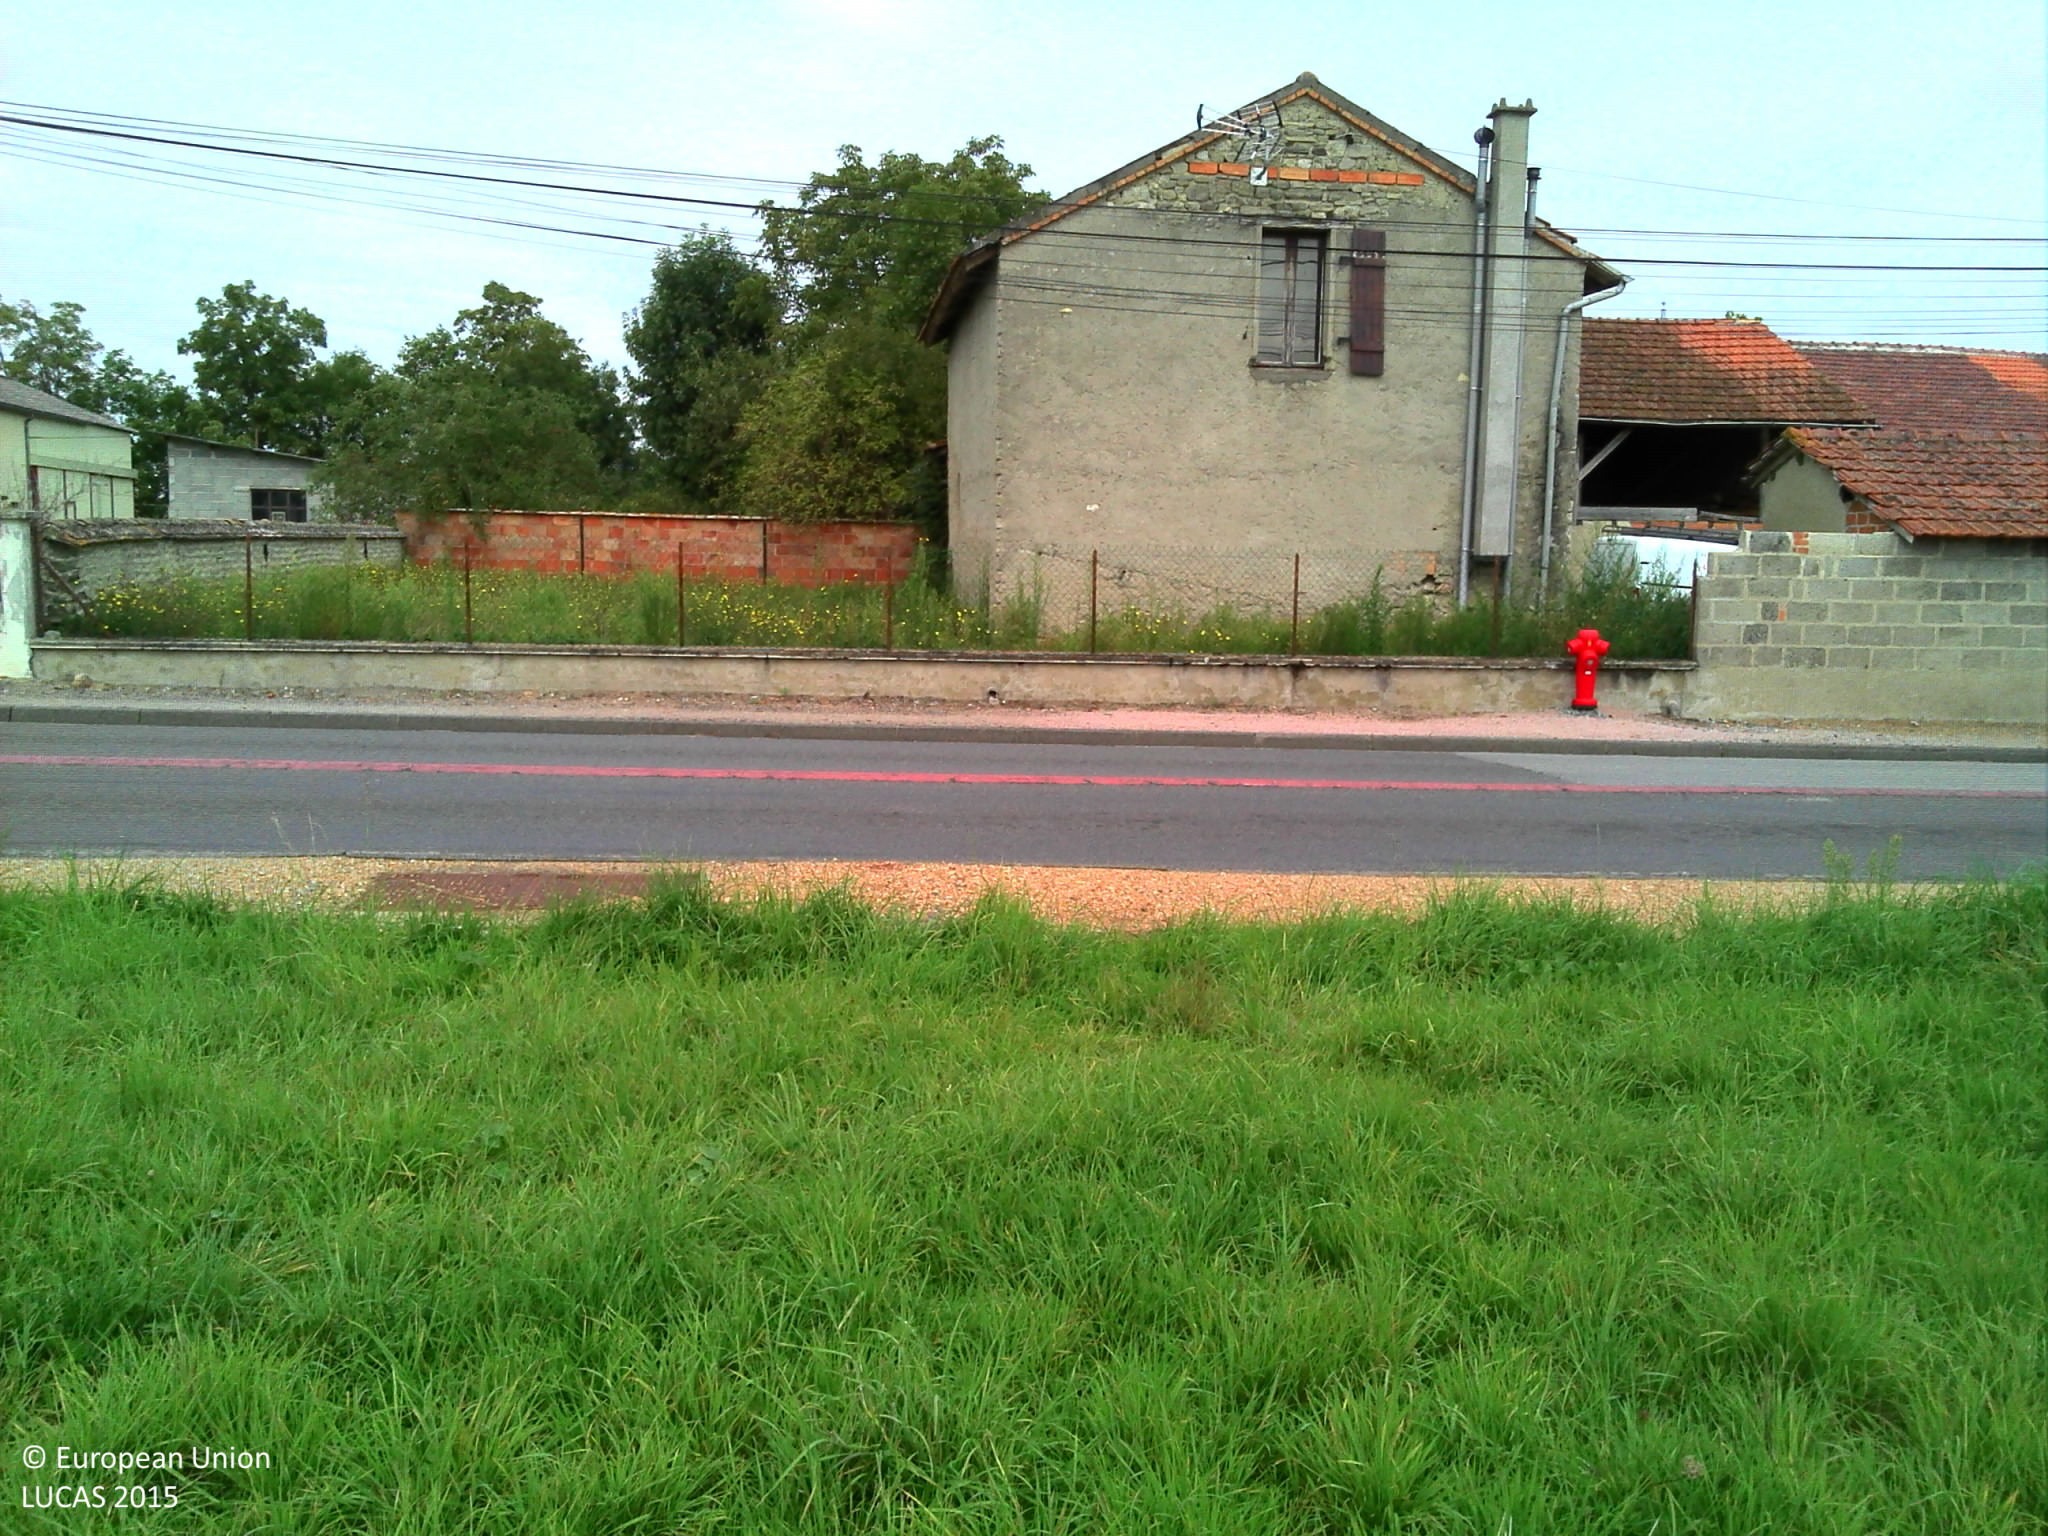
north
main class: Grassland
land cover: Grassland without tree/shrub cover
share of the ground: > 75 %
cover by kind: herbaceous plants 100 %
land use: Agriculture (excluding fallow land and kitchen gardens)
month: October
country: FR
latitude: 45.9964
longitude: 3.2986
